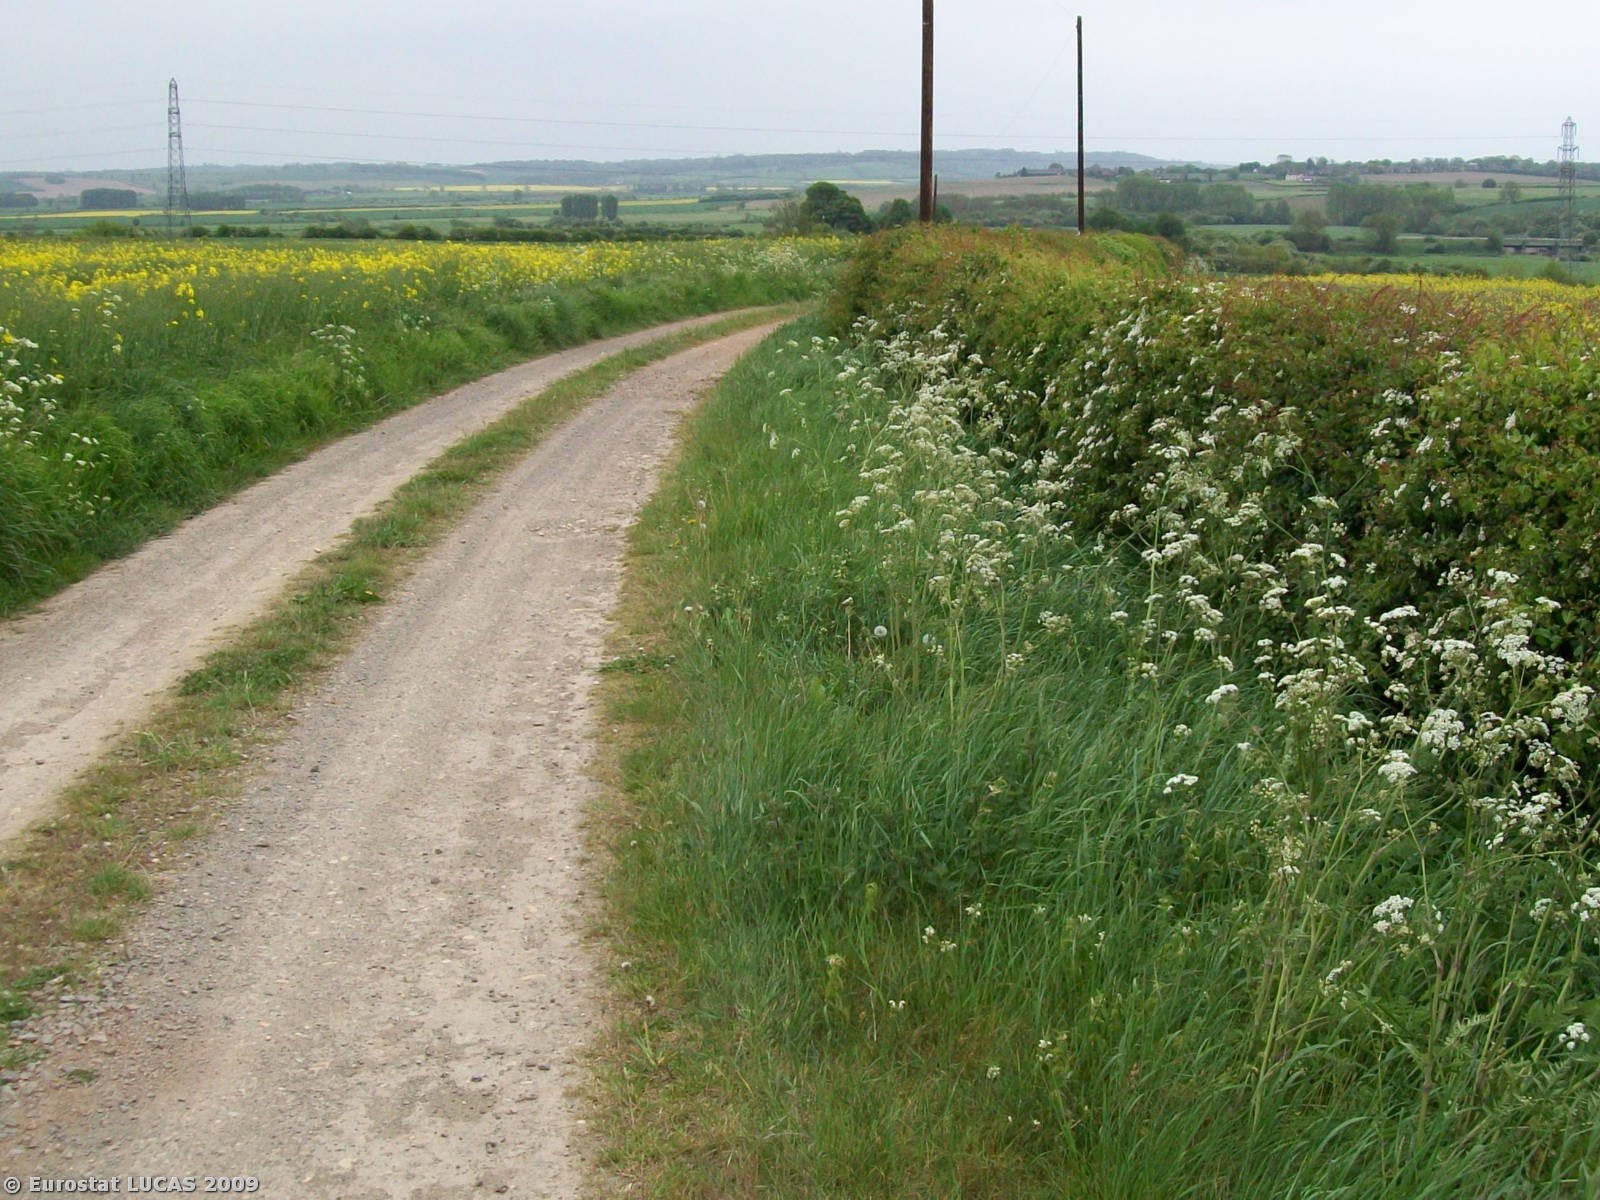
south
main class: Cropland
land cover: Rape and turnip rape
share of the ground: > 75 %
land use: Agriculture (excluding fallow land and kitchen gardens)
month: May
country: GB
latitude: 52.7680
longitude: -0.8467
